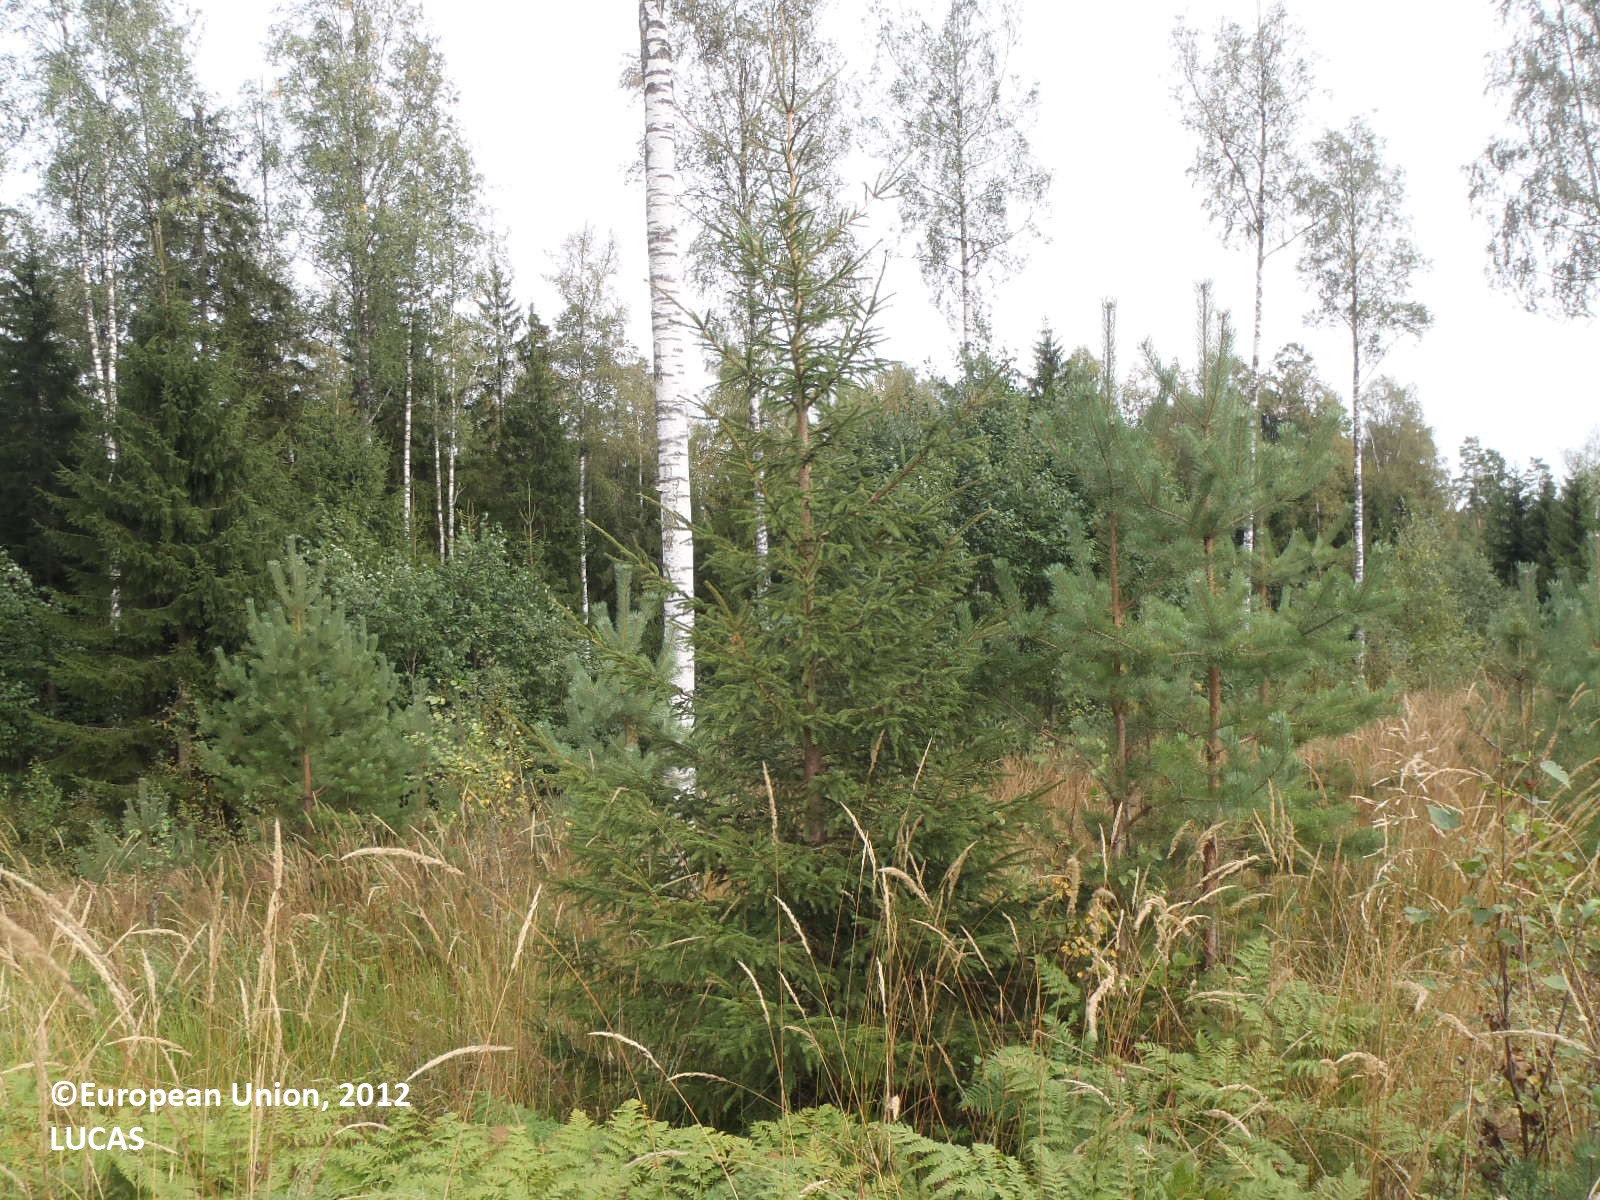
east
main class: Woodland
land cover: Other mixed woodland
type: boreal forest
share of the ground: 25 - 50 %
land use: Forestry
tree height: > 5 m
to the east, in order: Other mixed woodland; Spruce dominated mixed woodland; Tracks; Spruce dominated mixed woodland; Ditches and canals; Spruce dominated mixed woodland; Pine dominated mixed woodland; Ditches and canals; Pine dominated mixed woodland; Ditches and canals; Pine dominated mixed woodland
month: August
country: FI
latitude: 60.7728
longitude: 22.4981
